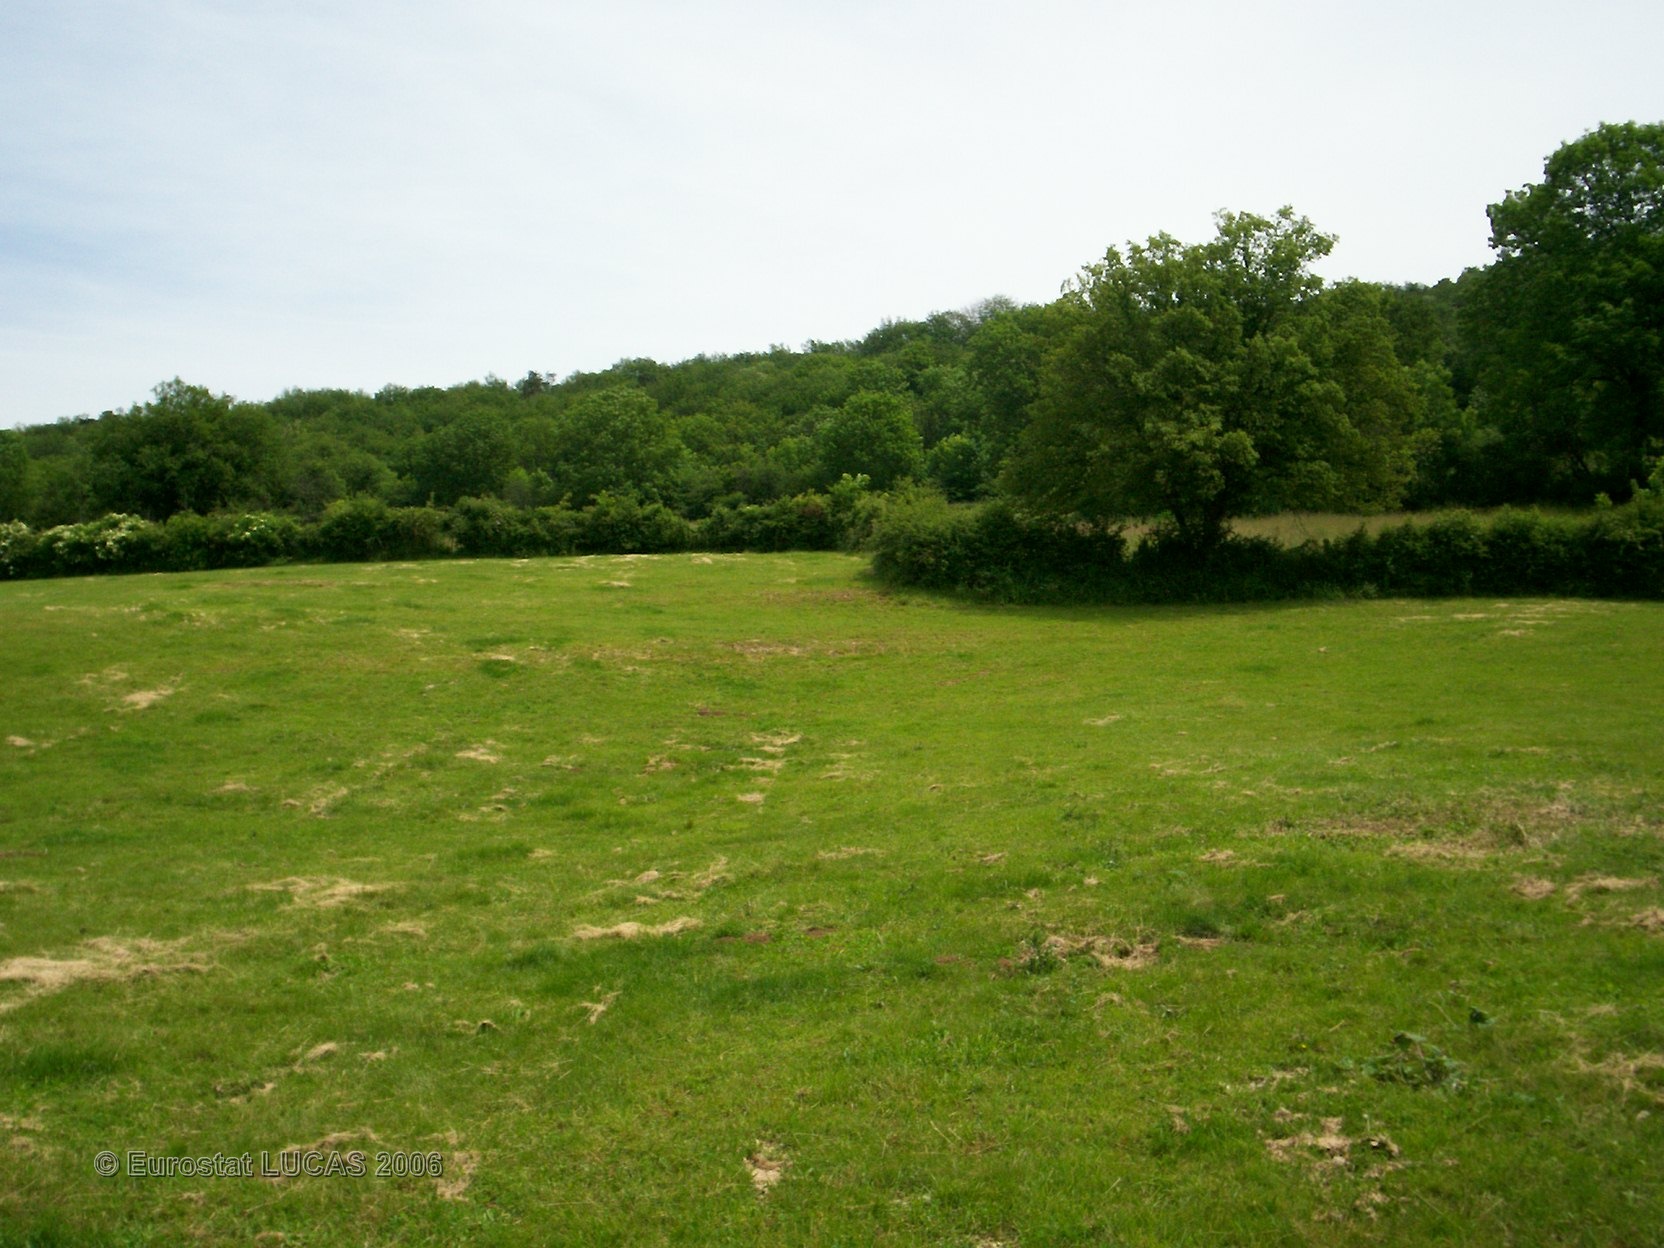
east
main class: Grassland
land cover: Grassland without tree/shrub cover
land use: Agriculture (excluding fallow land and kitchen gardens)
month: June
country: FR
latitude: 46.2151
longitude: 5.3754
